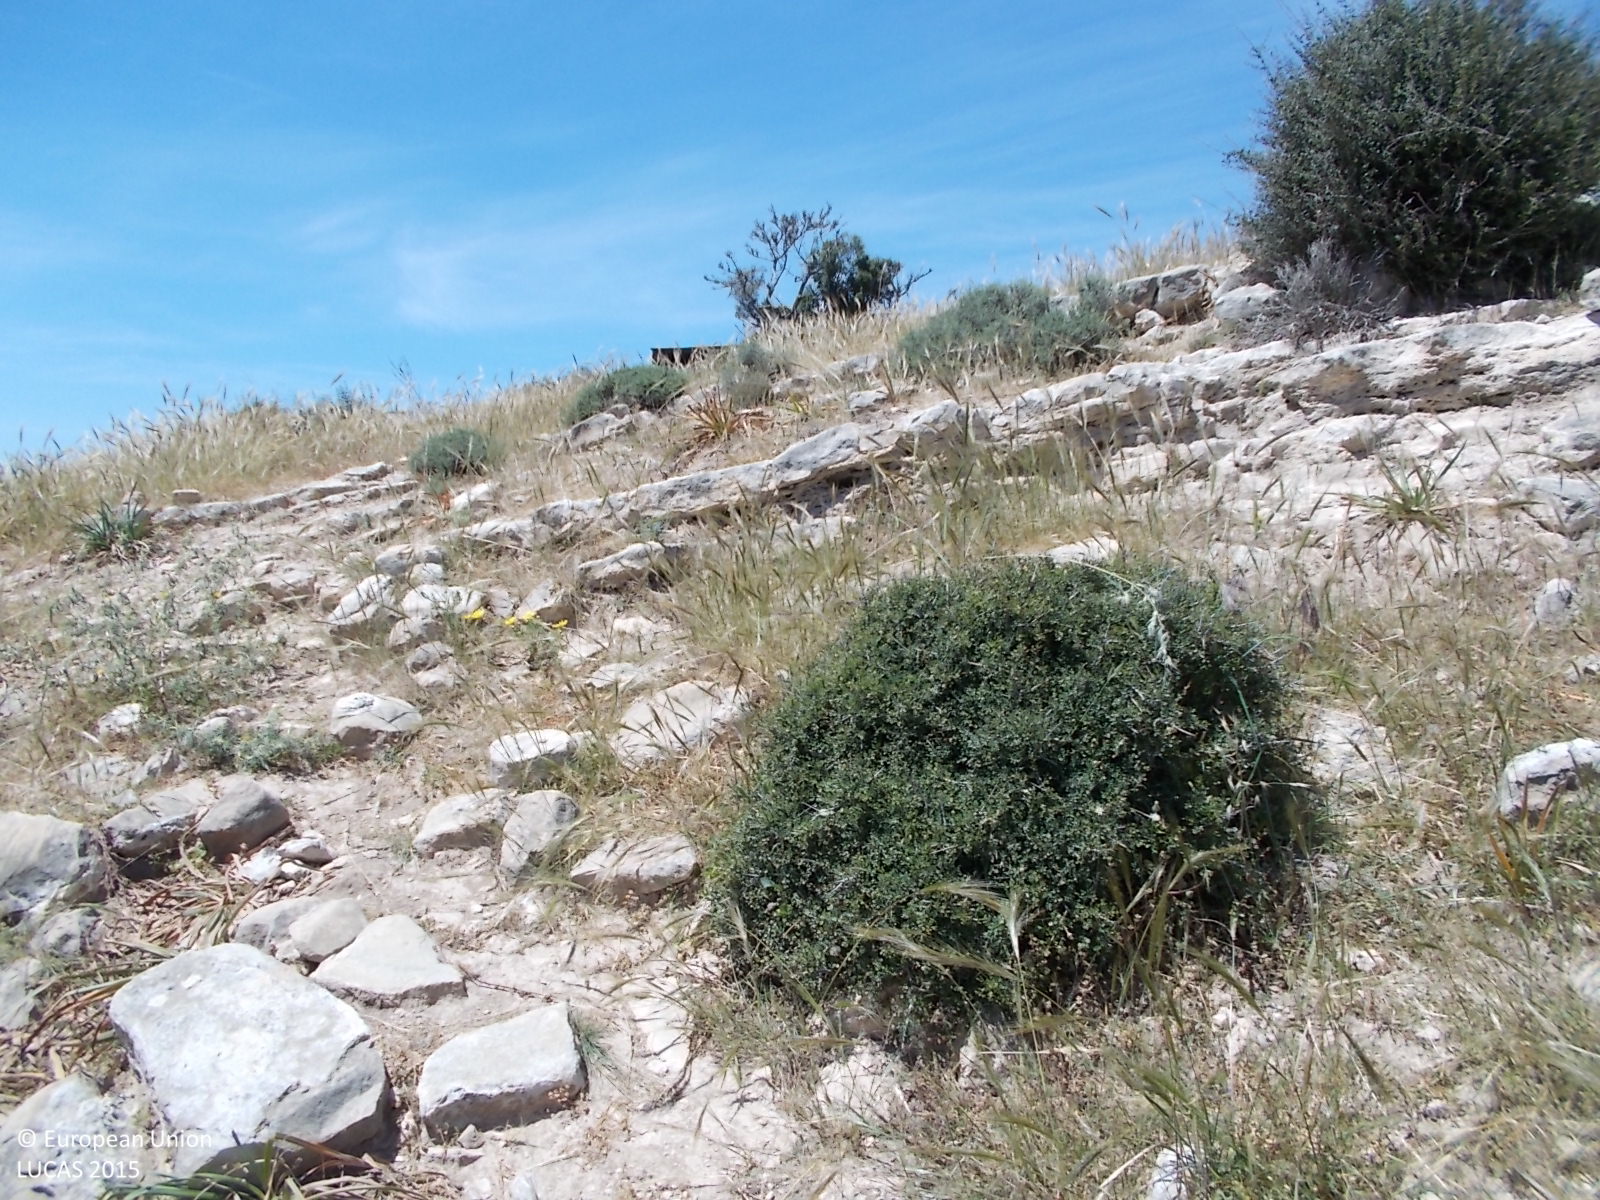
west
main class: Shrubland
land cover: Shrubland without tree cover
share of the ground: > 75 %
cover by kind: shrubs 75 %, herbaceous plants 15 %, unconsolidated bare surface 10 %
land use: Agriculture (excluding fallow land and kitchen gardens)
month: April
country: CY
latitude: 34.7274
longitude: 33.1134
